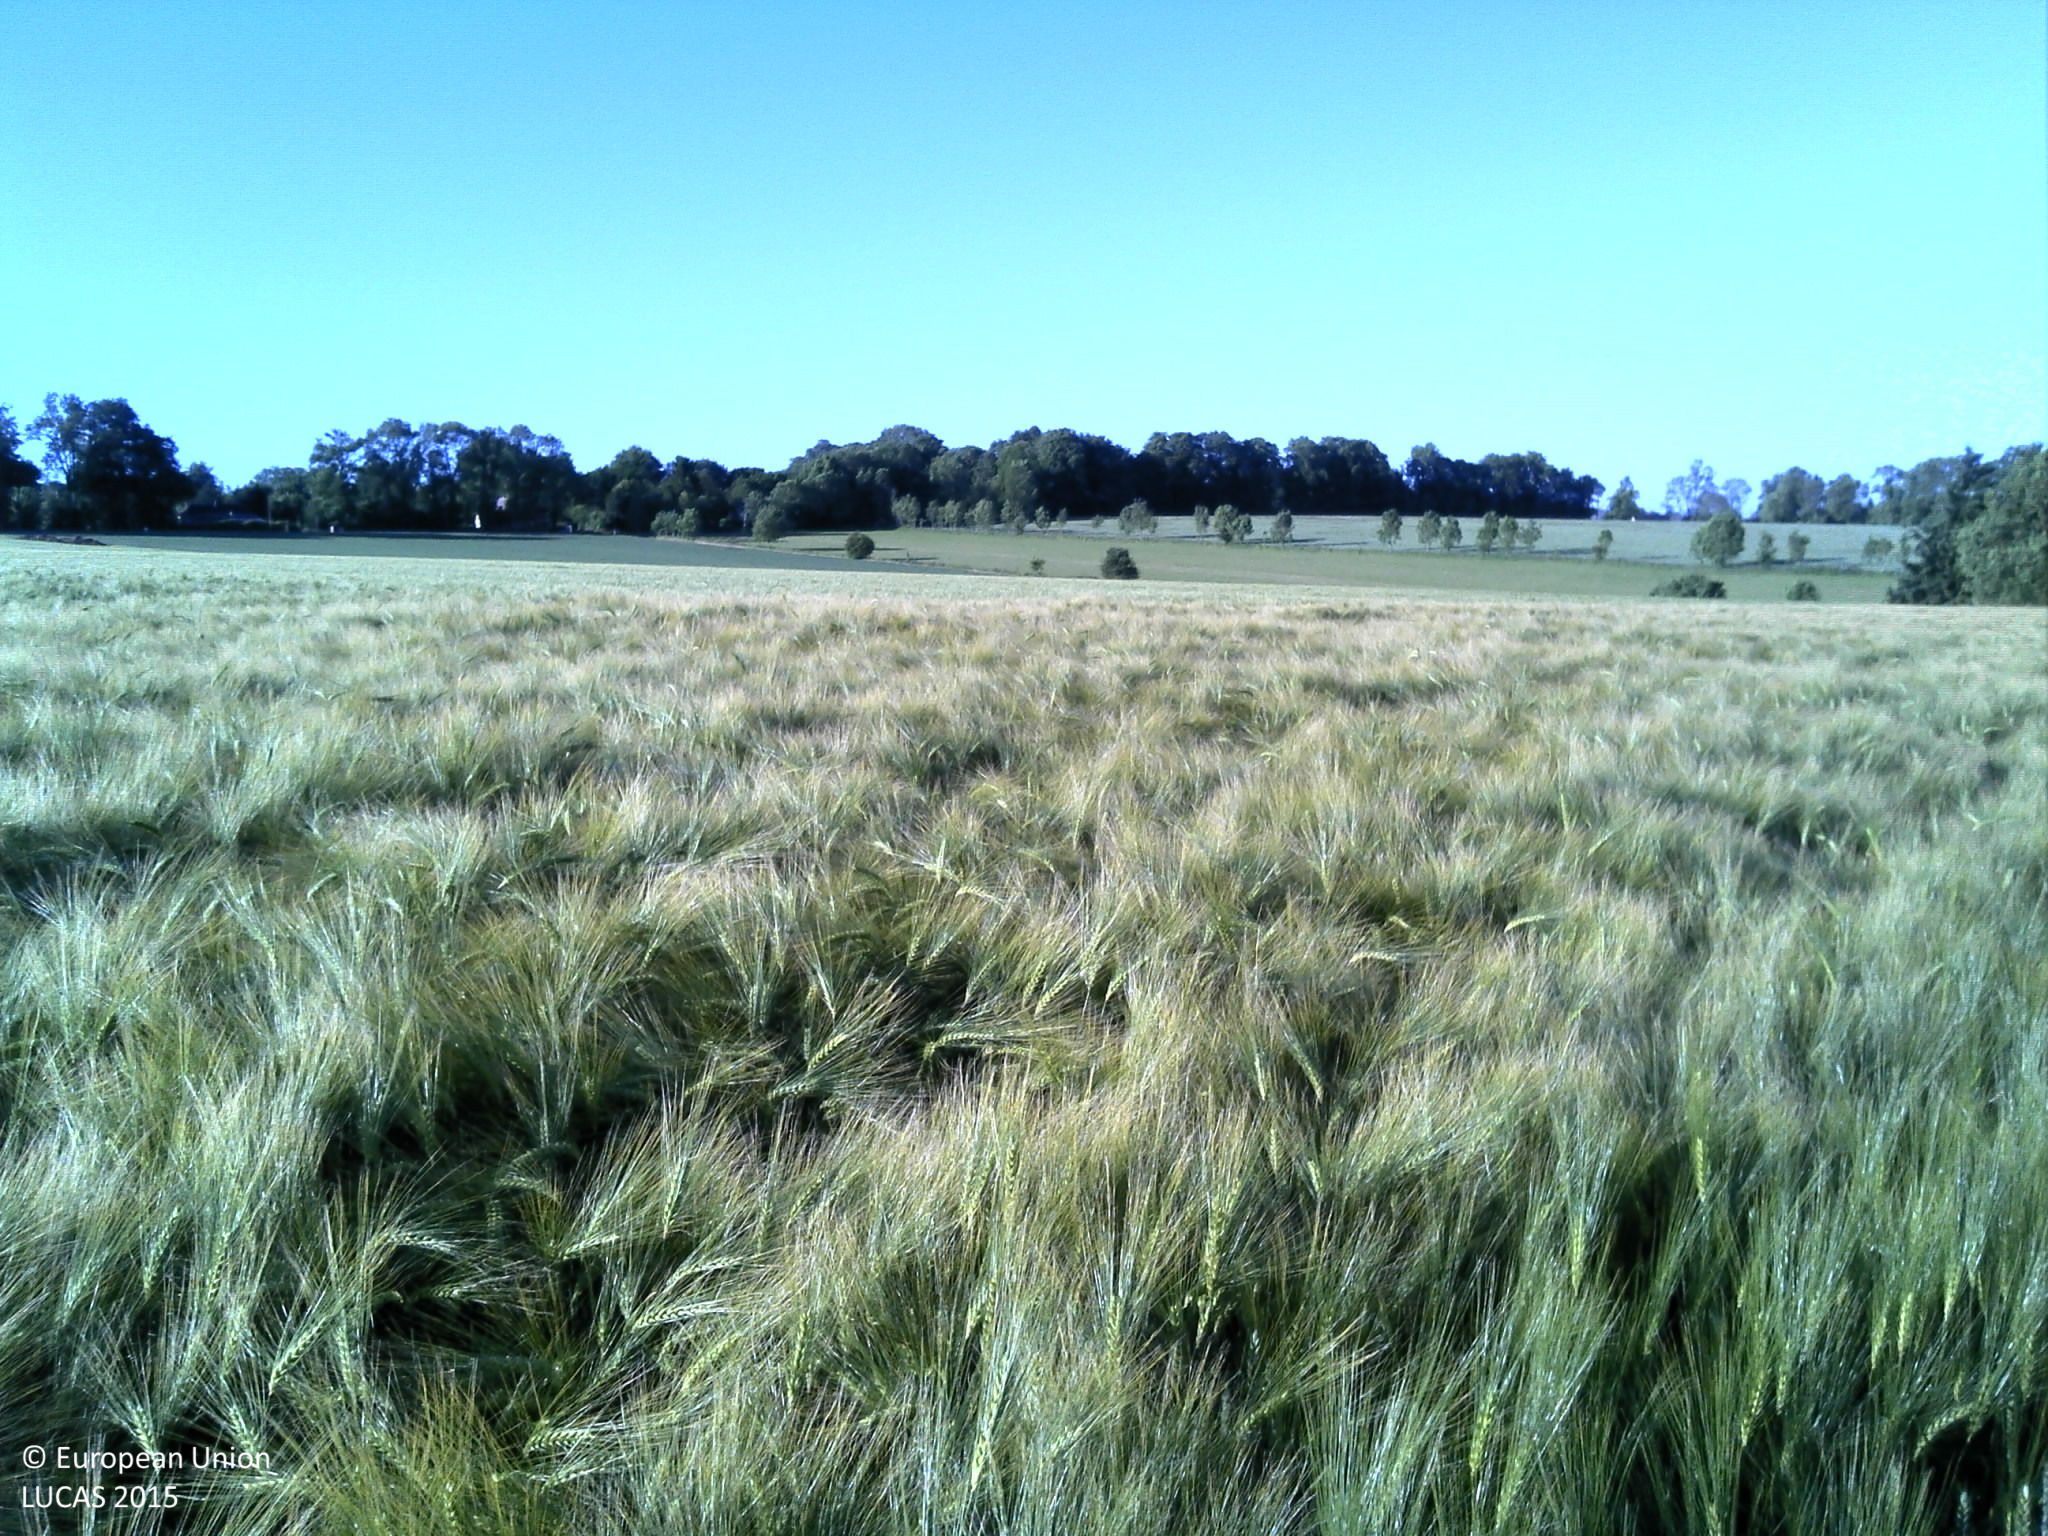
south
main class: Cropland
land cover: Common wheat
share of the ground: > 75 %
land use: Agriculture (excluding fallow land and kitchen gardens)
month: June
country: FR
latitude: 49.6102
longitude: 0.9959
